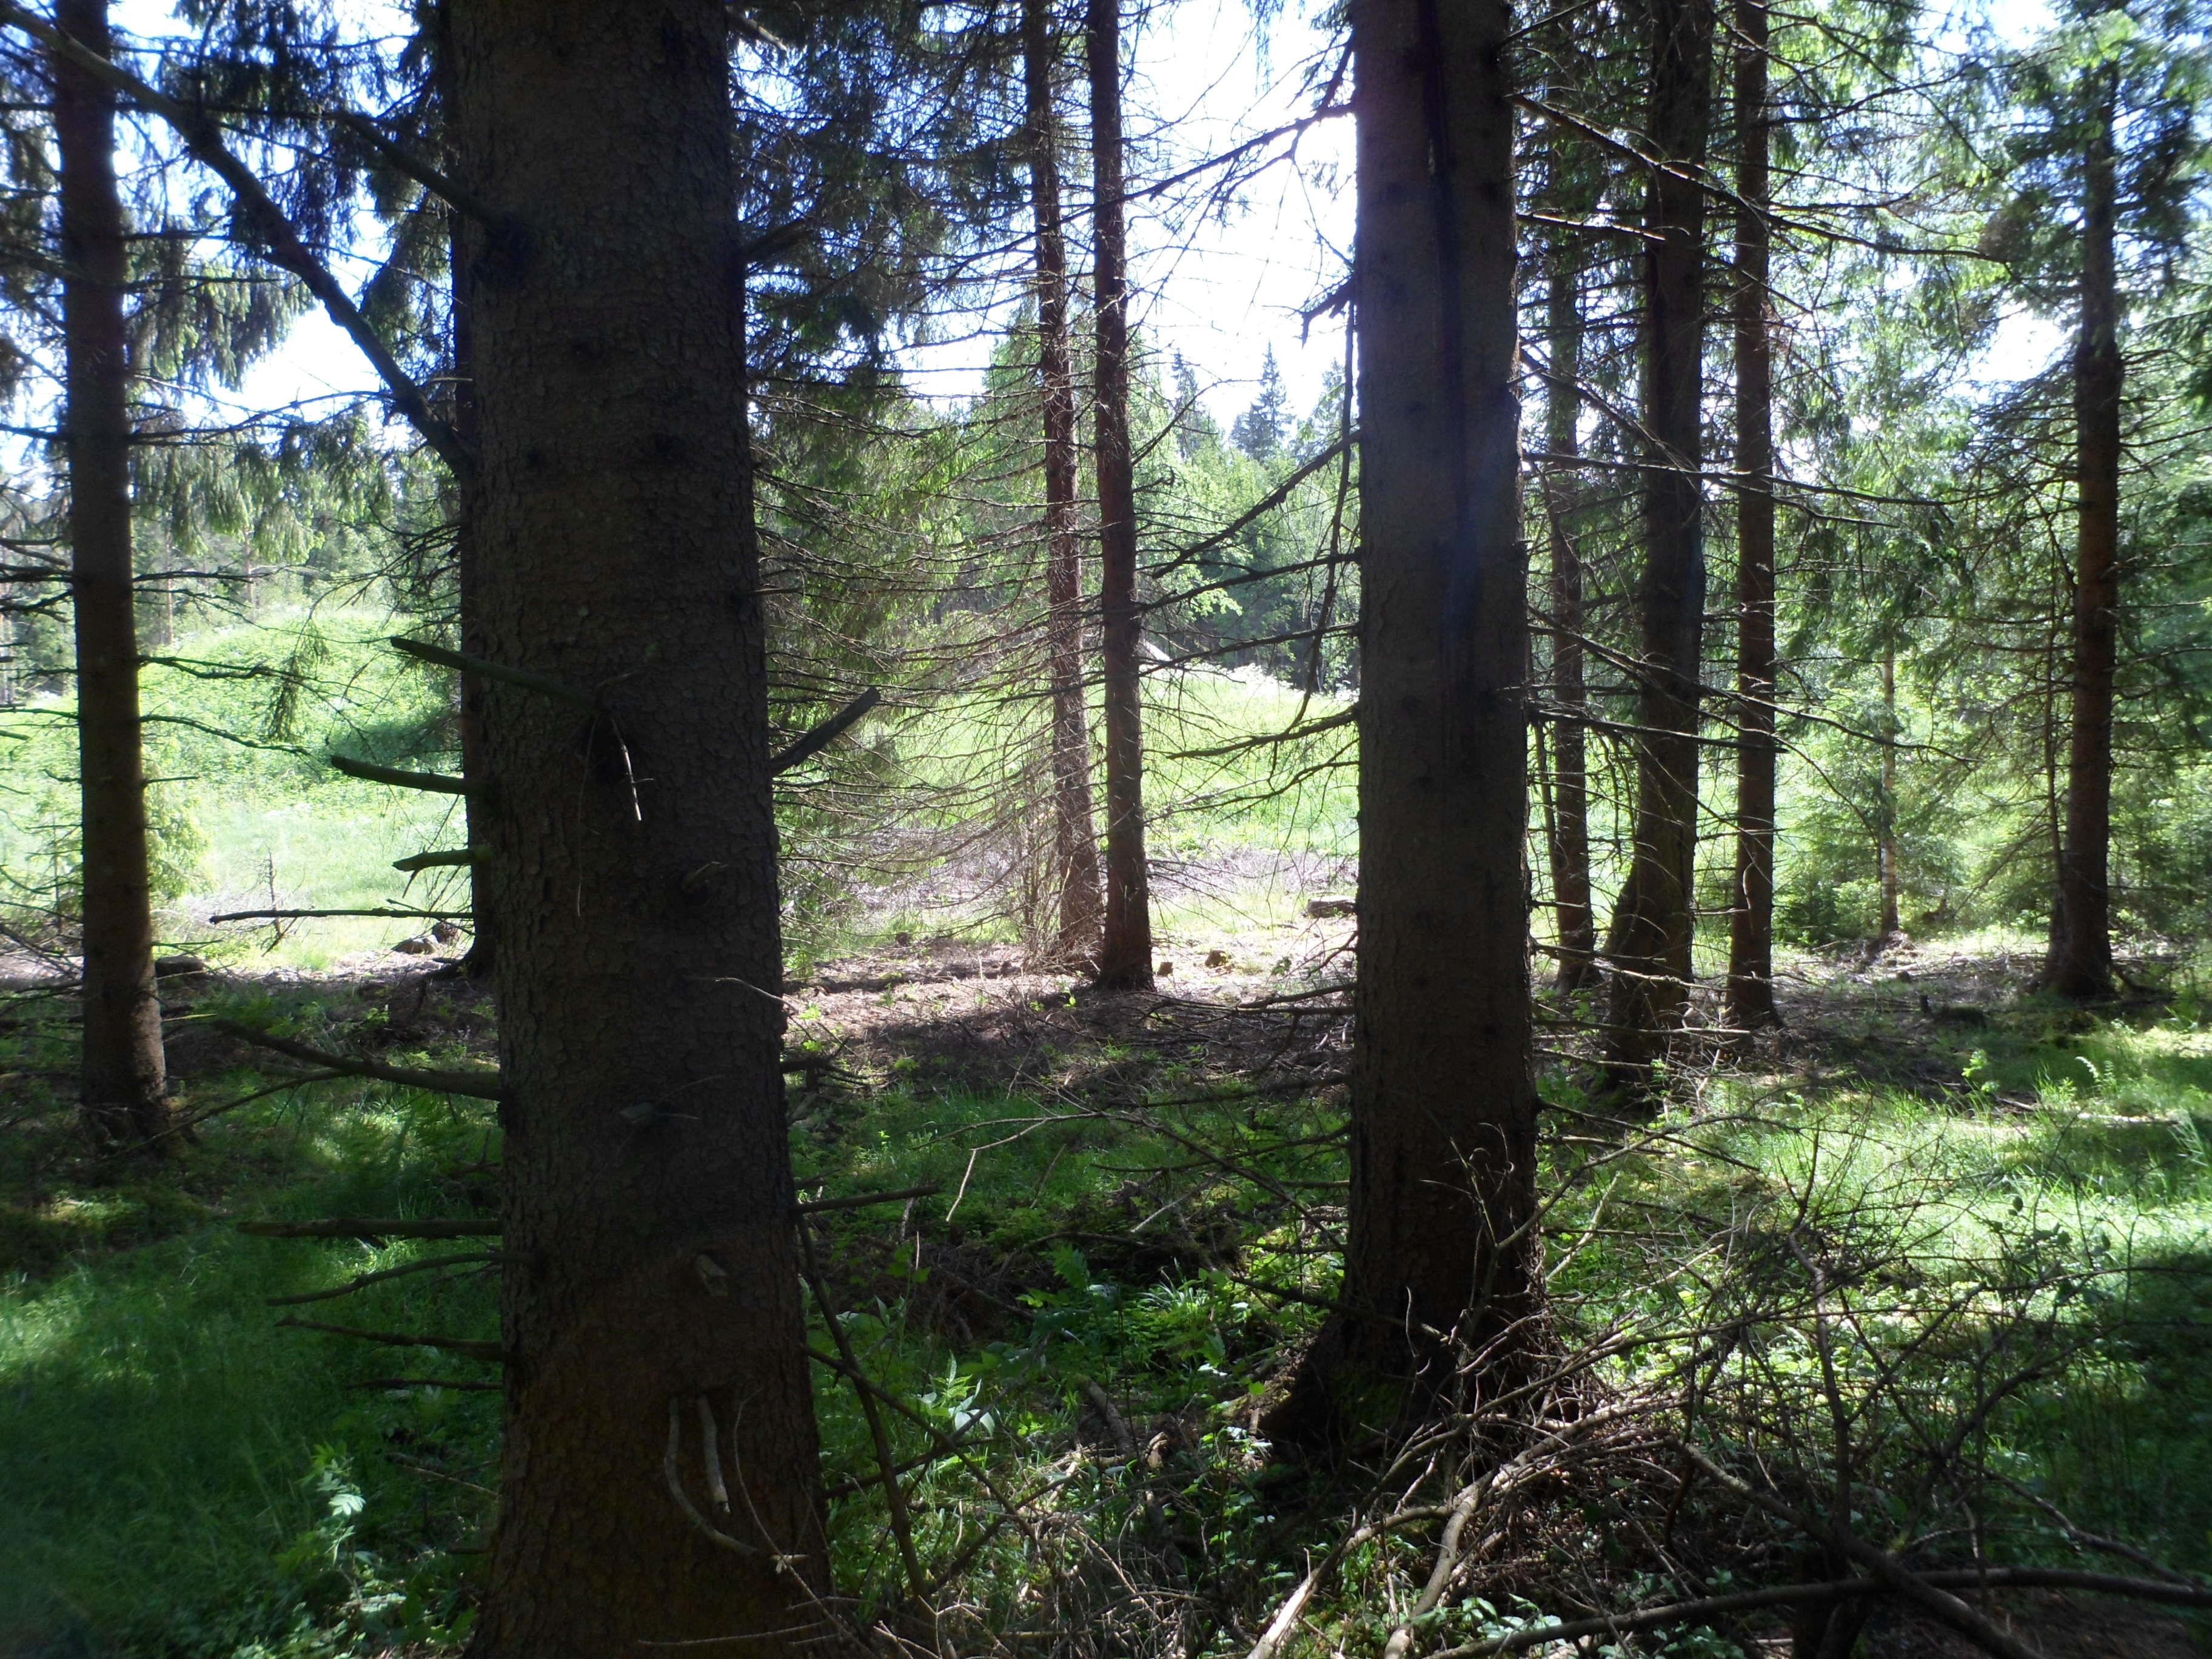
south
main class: Woodland
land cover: Spruce dominated coniferous woodland
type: boreal forest
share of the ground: 50 - 75 %
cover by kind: coniferous forest trees 60 %, herbaceous plants 20 %, shrubs 10 %, broadleaved forest trees 5 %, lichens and mosses 5 %
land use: Forestry
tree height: > 5 m
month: June
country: SE
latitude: 57.5060
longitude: 14.1847
